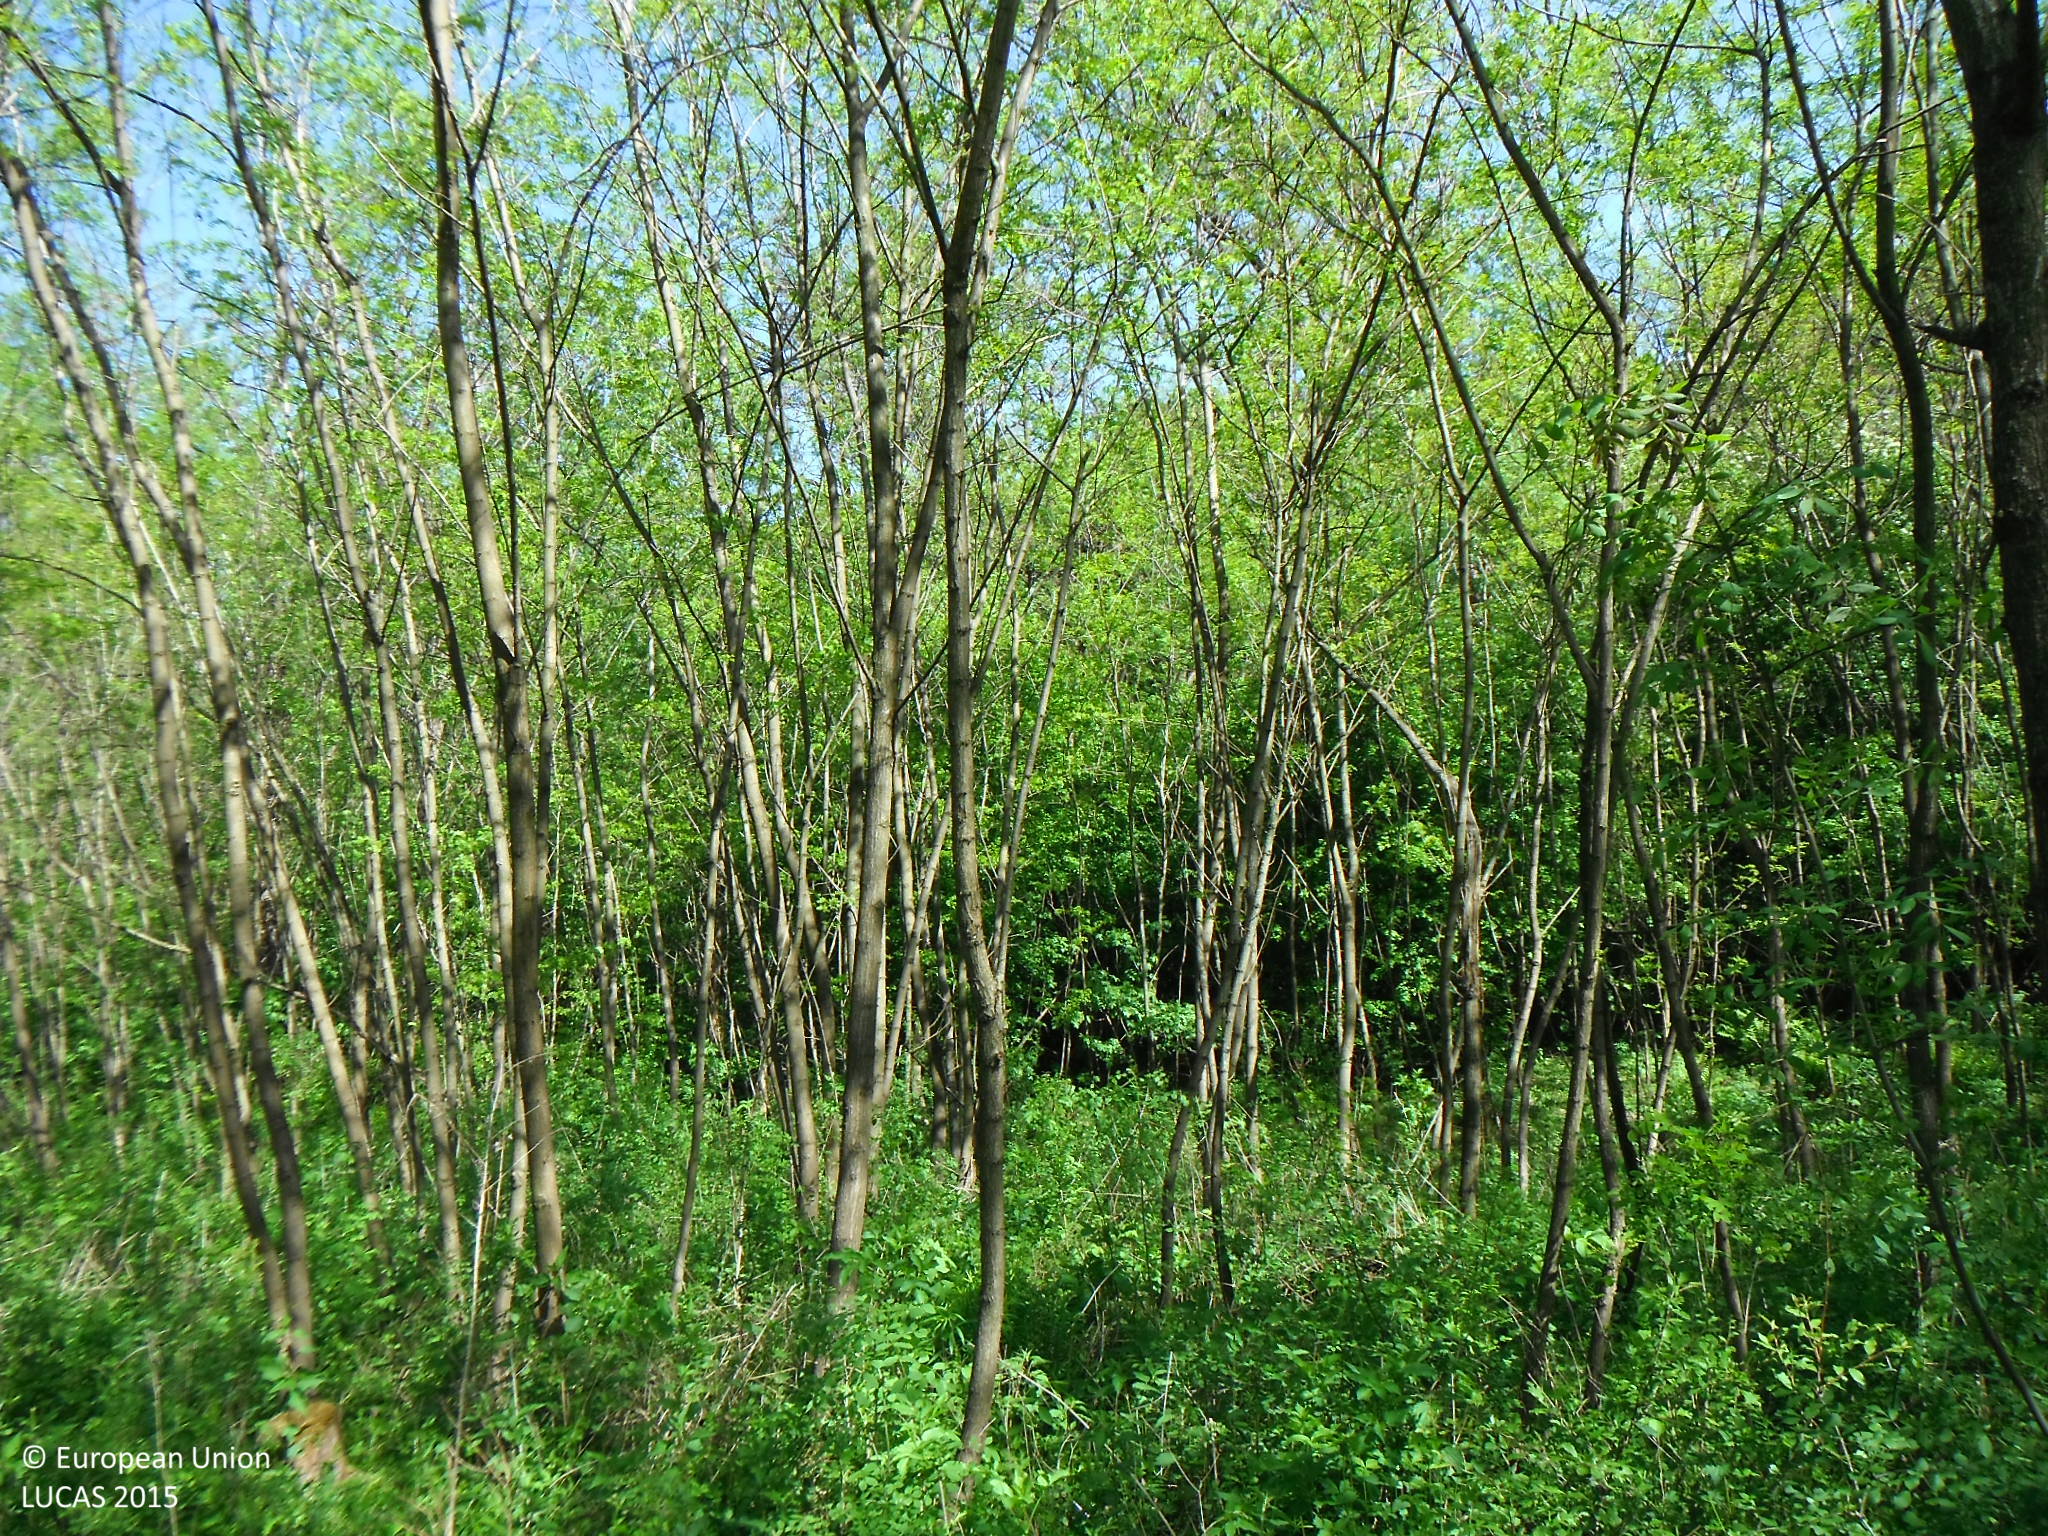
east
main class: Woodland
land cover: Broadleaved woodland
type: exotic forest
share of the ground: > 75 %
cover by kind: broadleaved forest trees 80 %, herbaceous plants 20 %
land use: Forestry
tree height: > 5 m
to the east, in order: Broadleaved woodland; Tracks; Broadleaved woodland
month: May
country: SK
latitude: 48.4940
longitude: 21.1250
